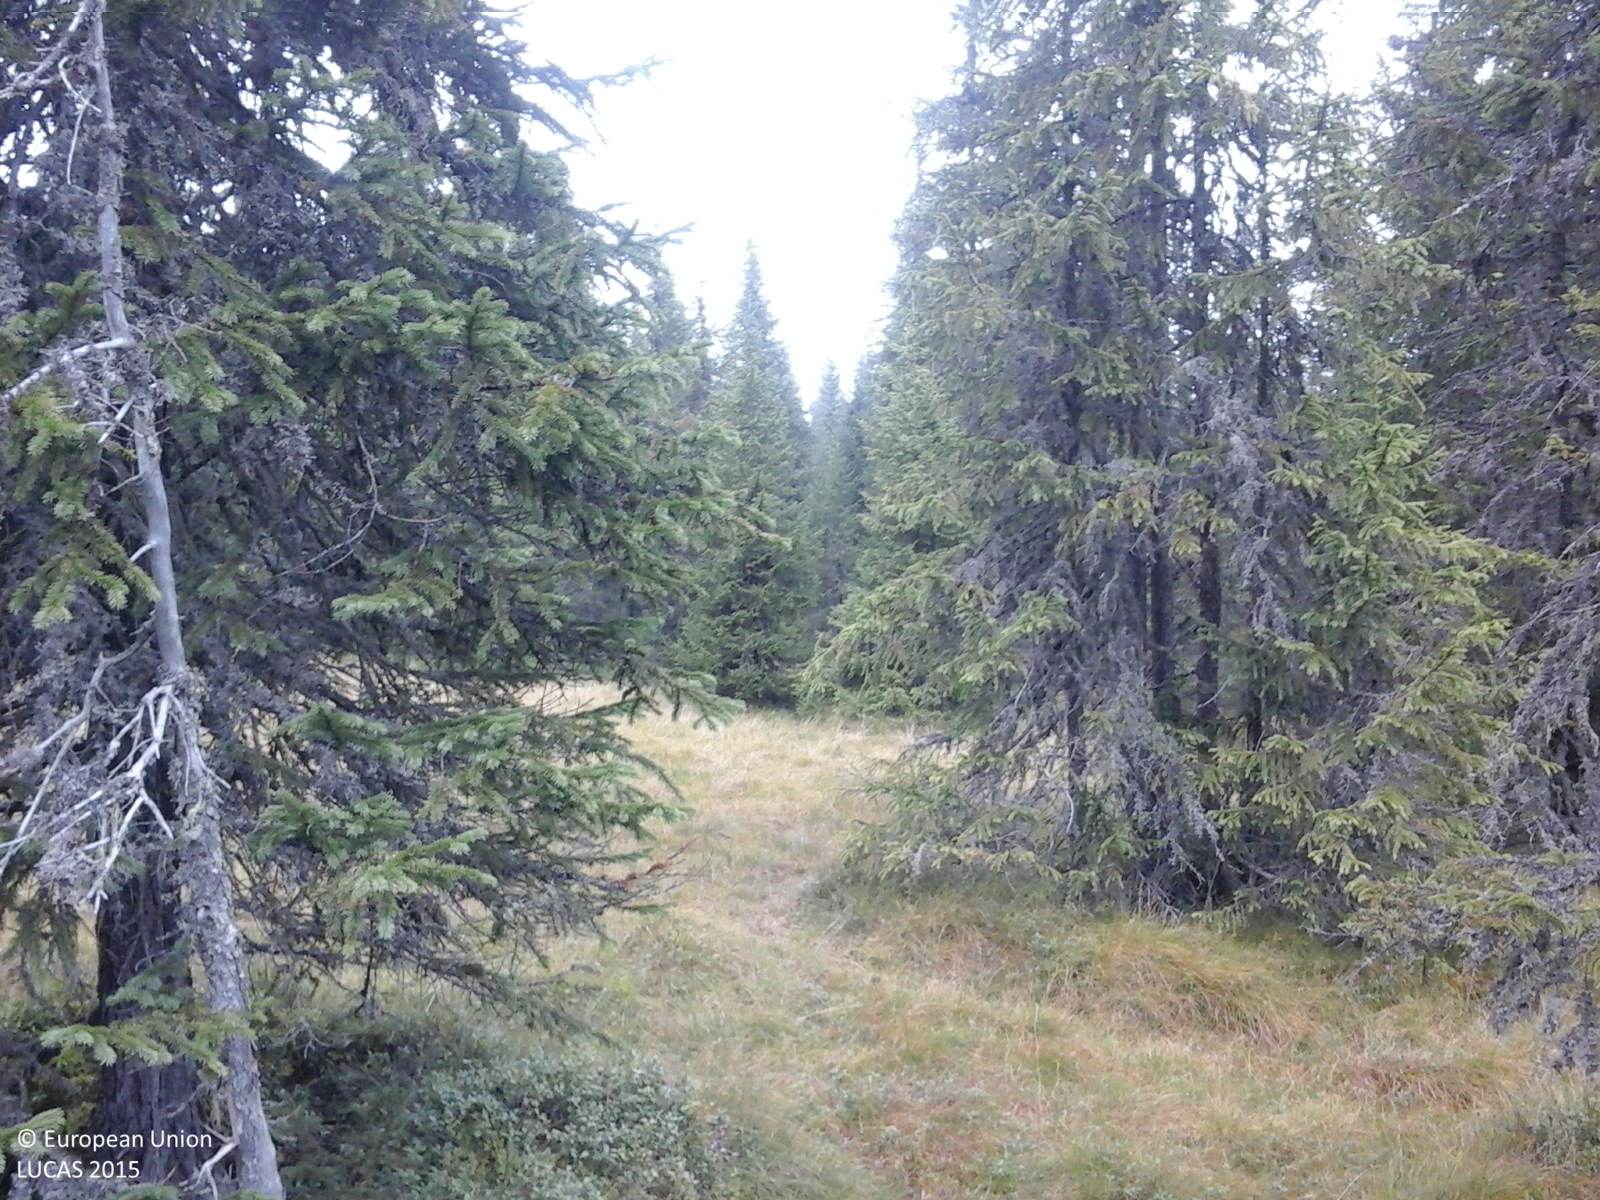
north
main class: Woodland
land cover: Spruce dominated coniferous woodland
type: alpine coniferous forest
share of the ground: > 75 %
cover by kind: coniferous forest trees 100 %
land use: Forestry
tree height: > 5 m
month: October
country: RO
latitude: 46.5185
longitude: 23.1619
